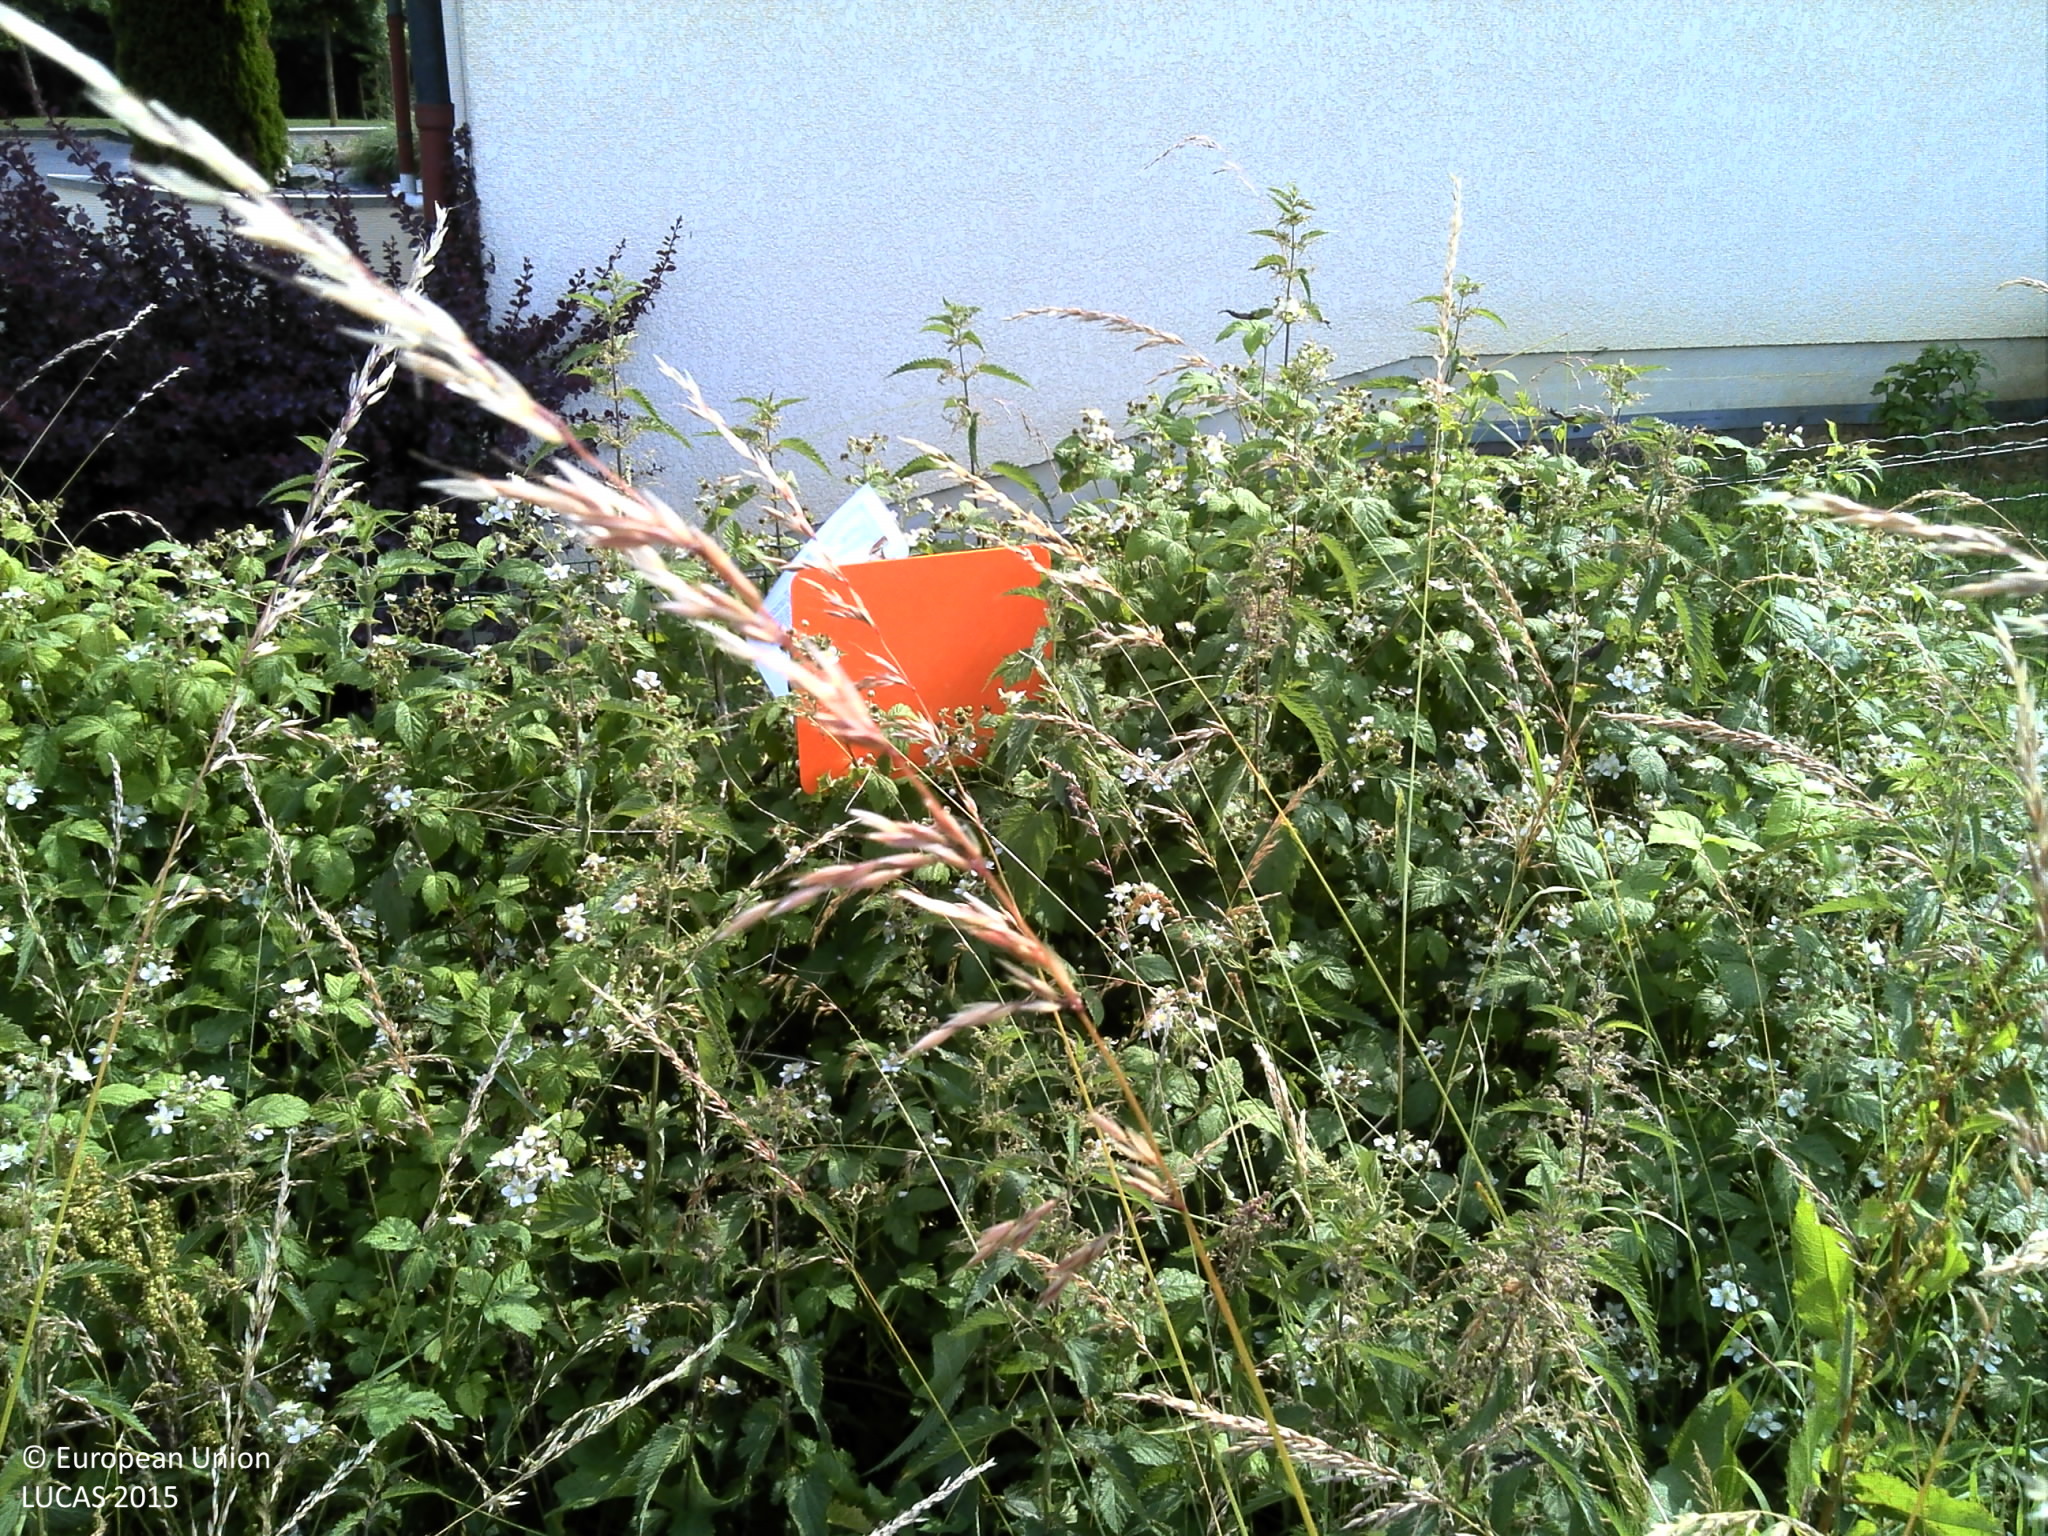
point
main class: Grassland
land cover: Grassland without tree/shrub cover
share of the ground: > 75 %
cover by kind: herbaceous plants 100 %
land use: Residential
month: June
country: FR
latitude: 49.7422
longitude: 4.8209
